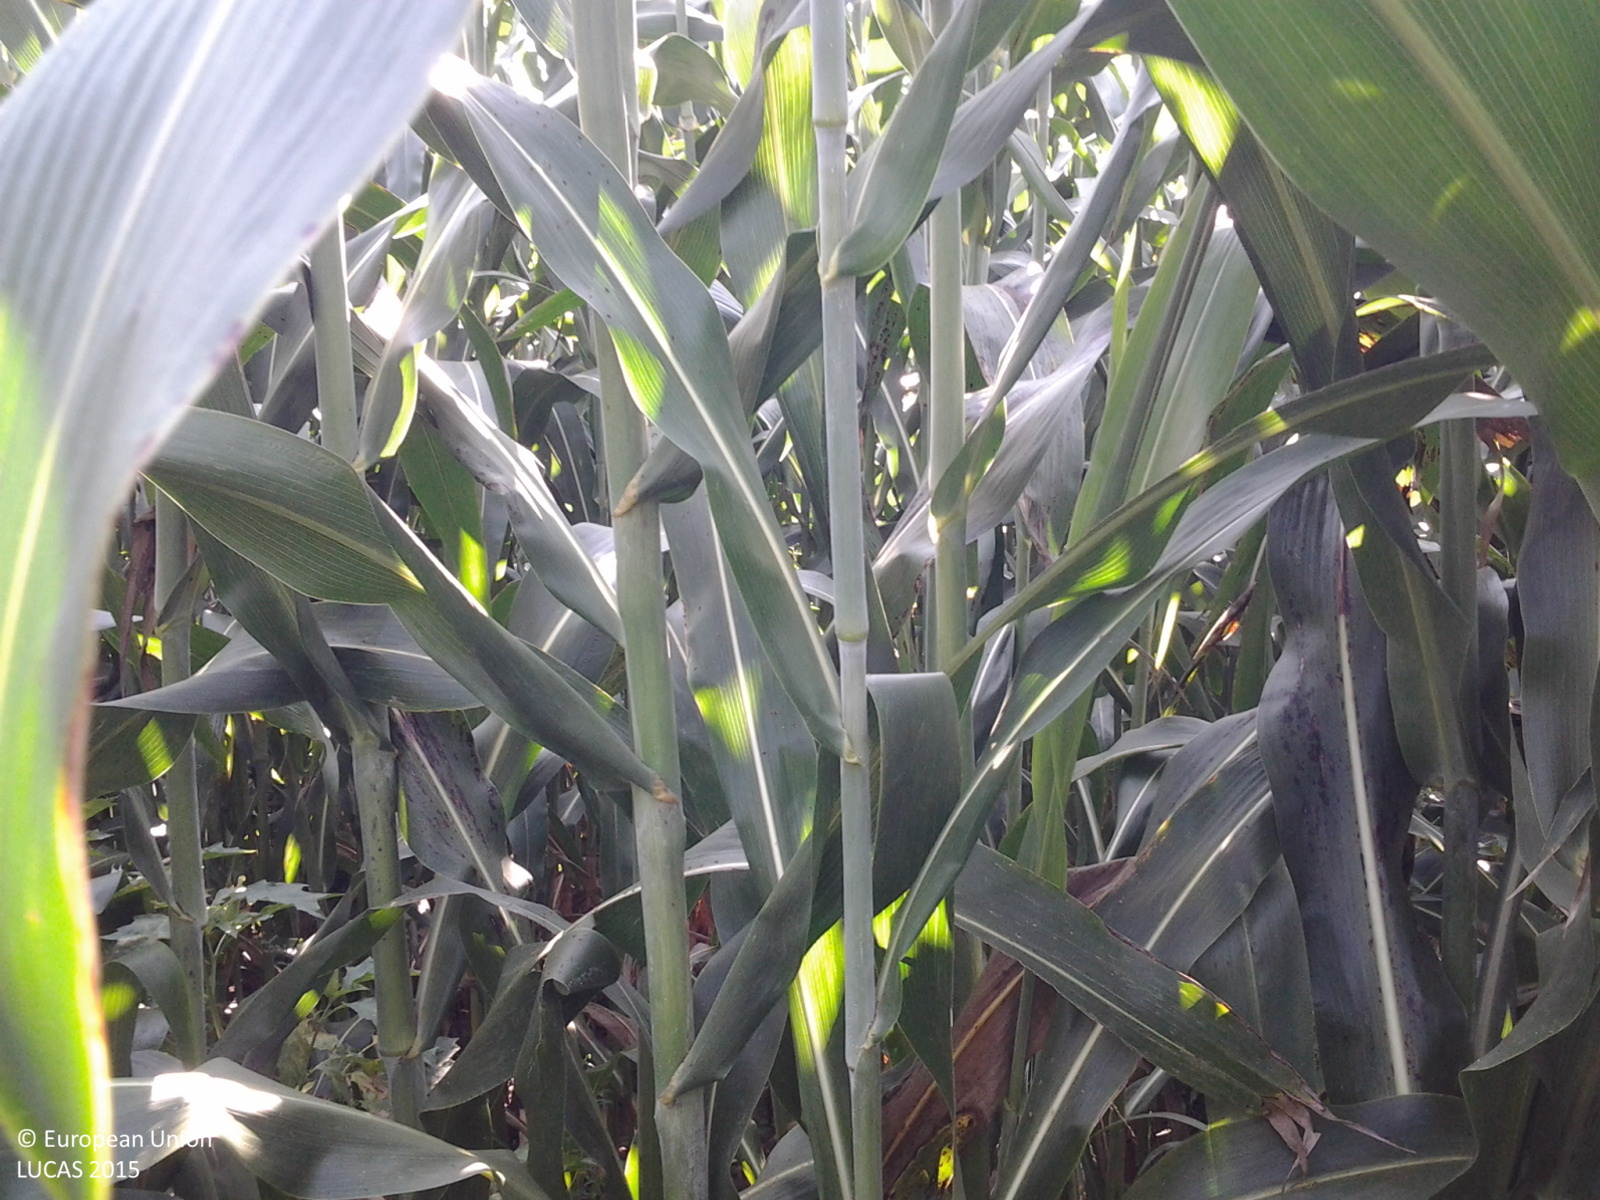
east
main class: Cropland
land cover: Other cereals
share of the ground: > 75 %
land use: Agriculture (excluding fallow land and kitchen gardens)
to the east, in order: Other cereals; Shrubland with sparse tree cover; Grass margins; Tracks; Cherry fruit; Triticale; Grass margins; Tracks; Grass margins; Triticale
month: August
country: HU
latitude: 47.1803
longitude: 19.8806
